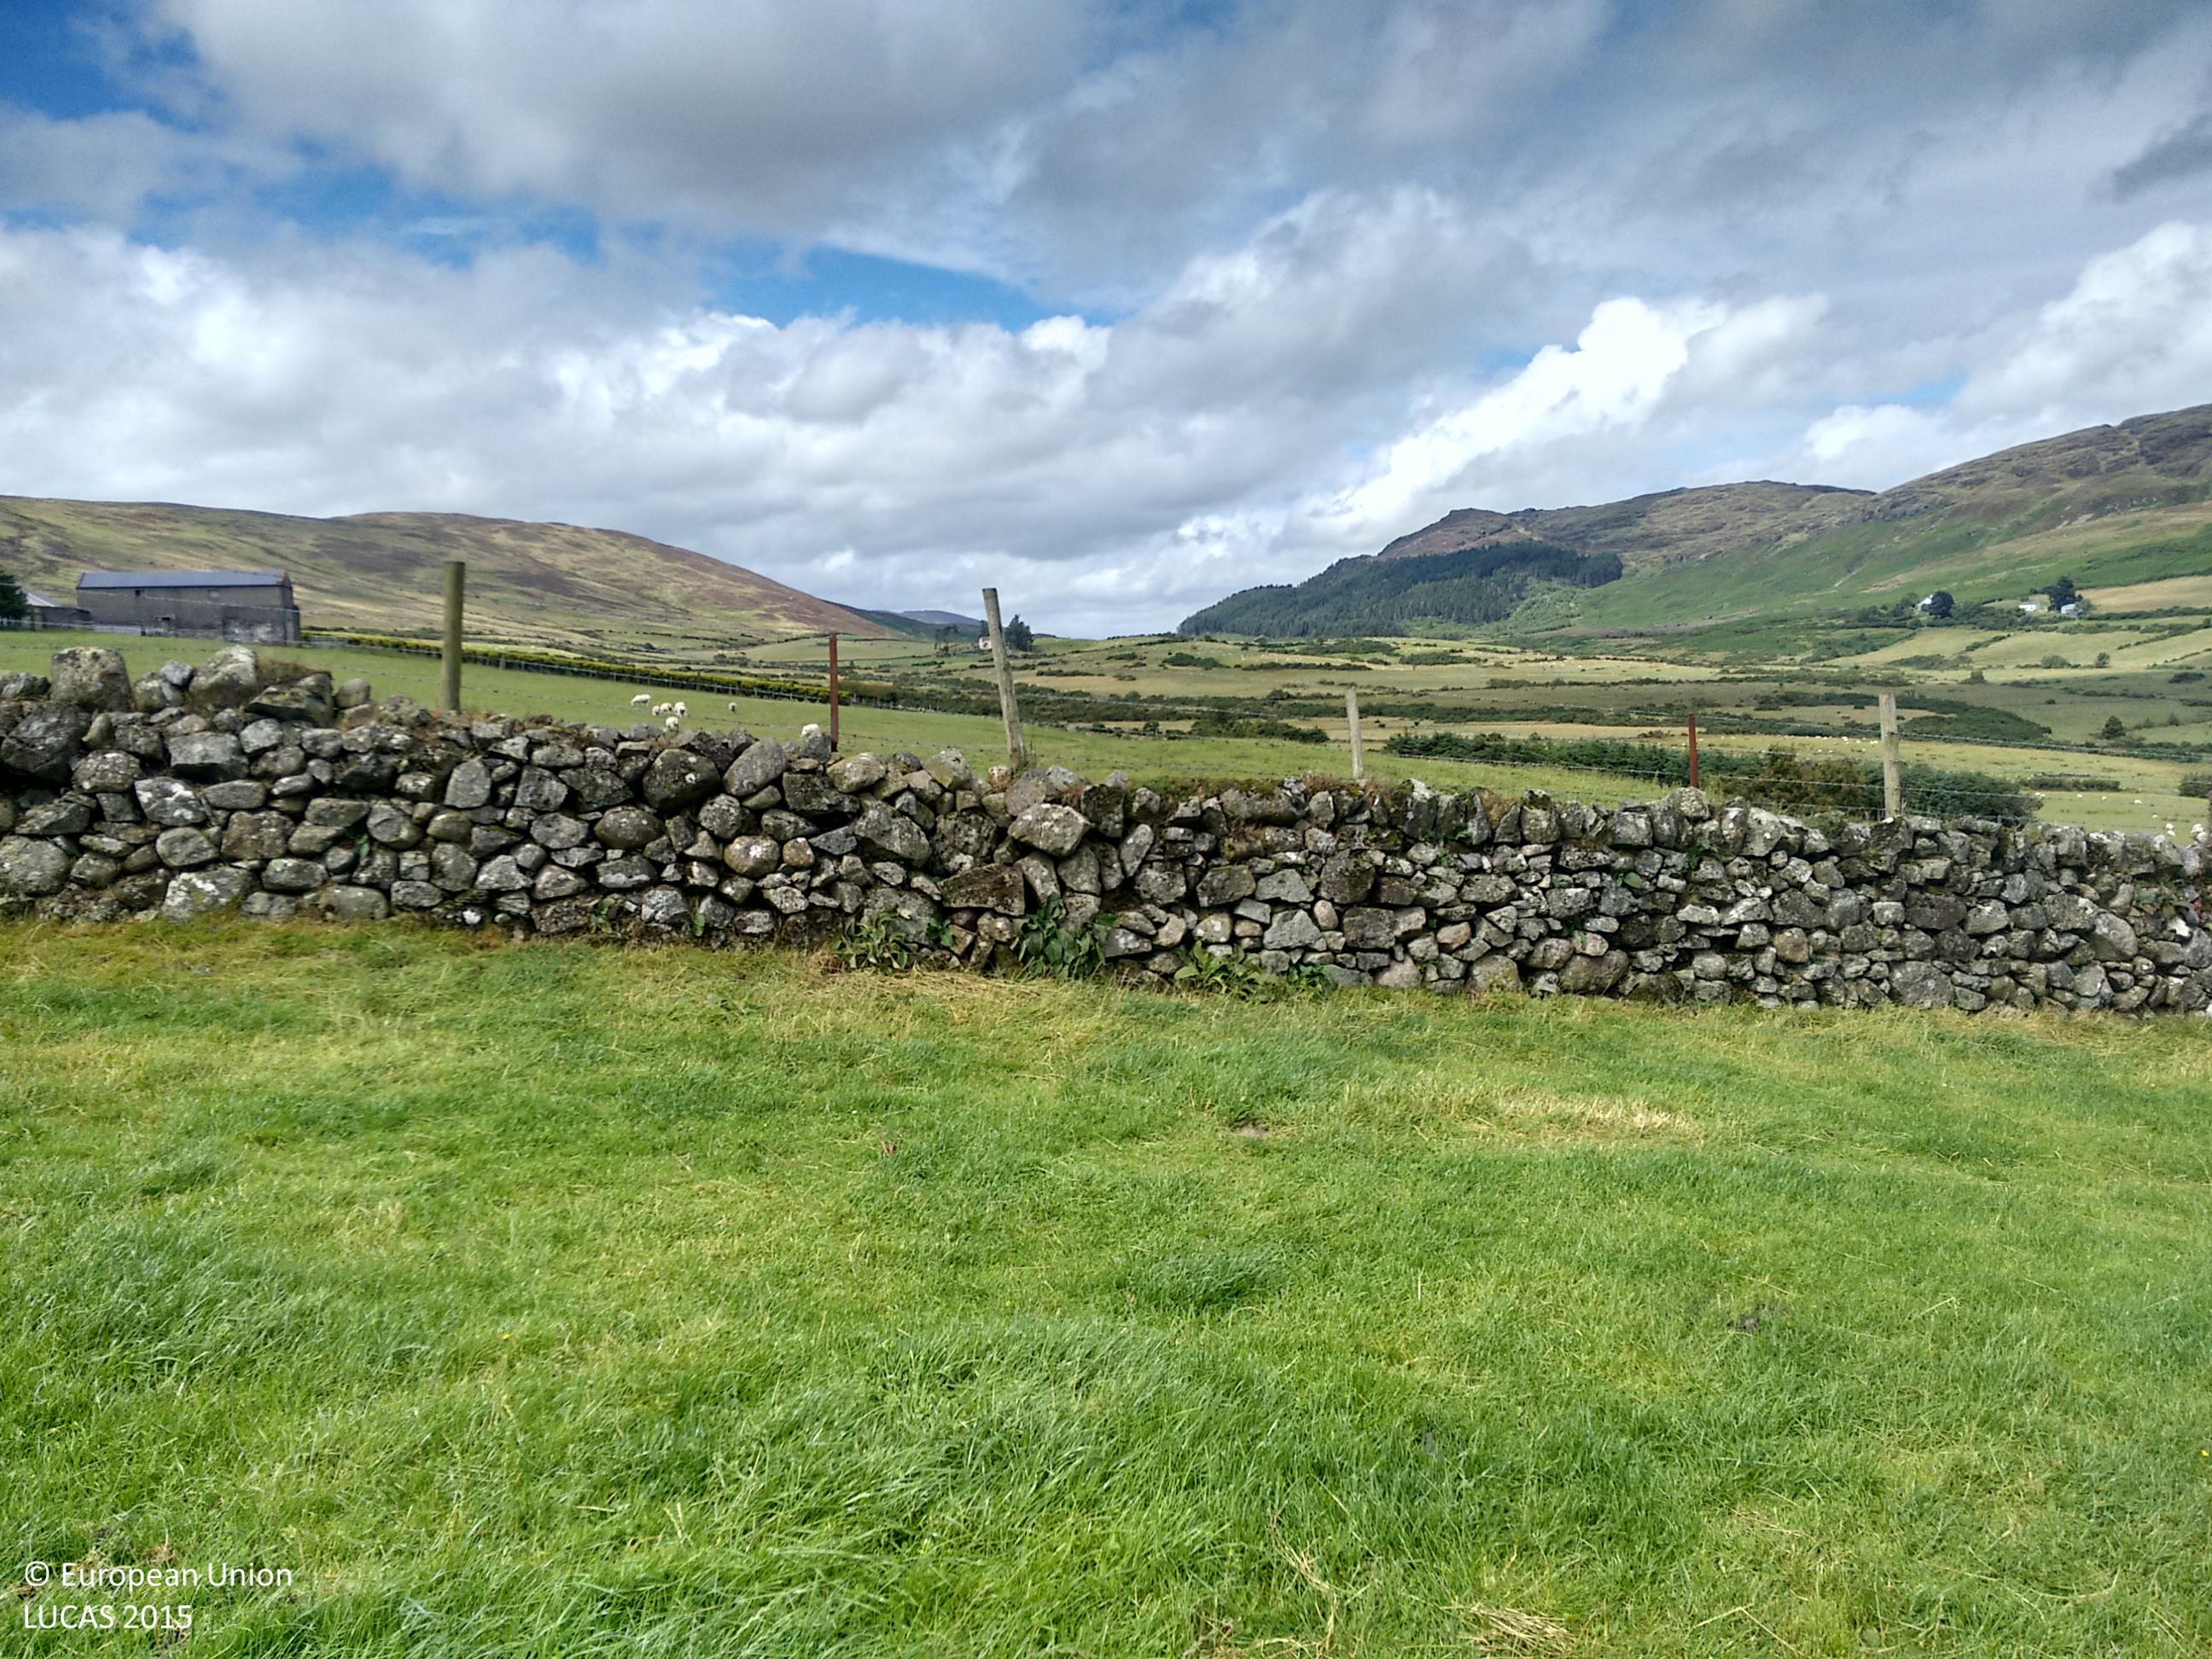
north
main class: Grassland
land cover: Grassland without tree/shrub cover
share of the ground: > 75 %
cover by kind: herbaceous plants 100 %
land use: Agriculture (excluding fallow land and kitchen gardens)
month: August
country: IE
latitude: 54.0374
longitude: -6.2582
